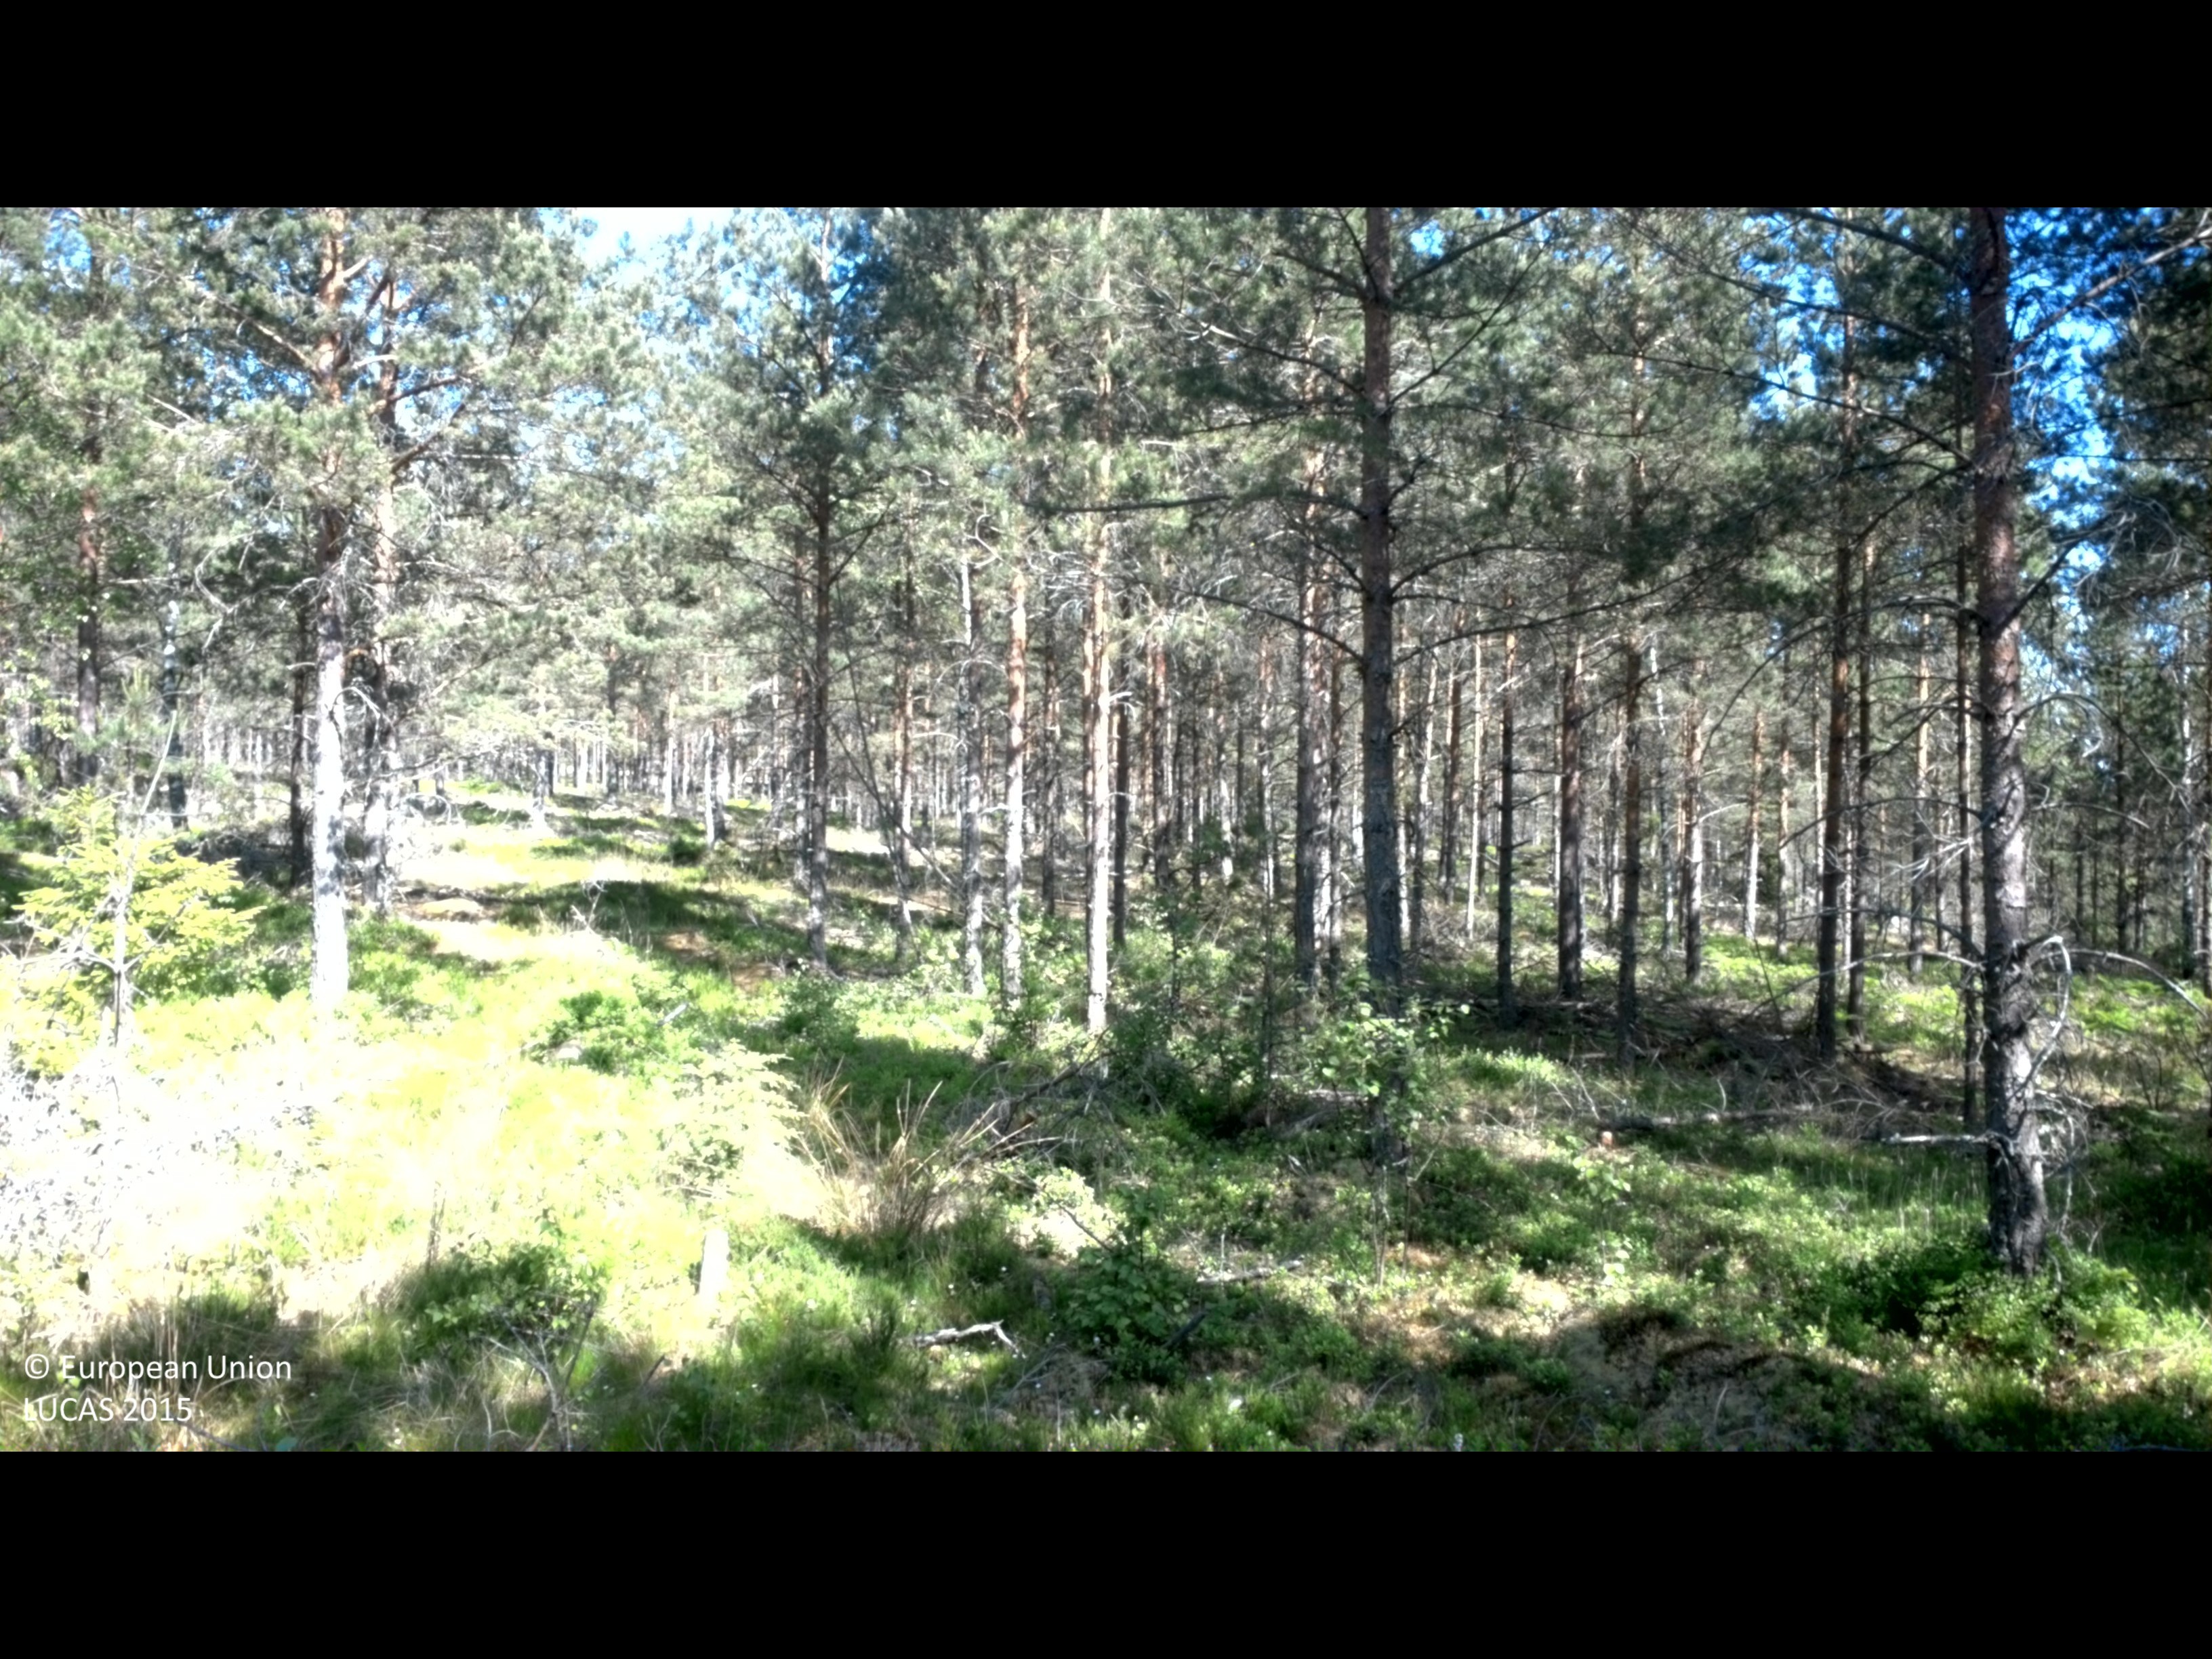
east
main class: Woodland
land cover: Pine dominated coniferous woodland
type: boreal forest
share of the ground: 50 - 75 %
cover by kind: coniferous forest trees 60 %, shrubs 20 %, herbaceous plants 10 %, broadleaved forest trees 5 %, lichens and mosses 5 %
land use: Forestry
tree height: > 5 m
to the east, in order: Pine dominated coniferous woodland
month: June
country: SE
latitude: 57.6414
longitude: 16.6162
